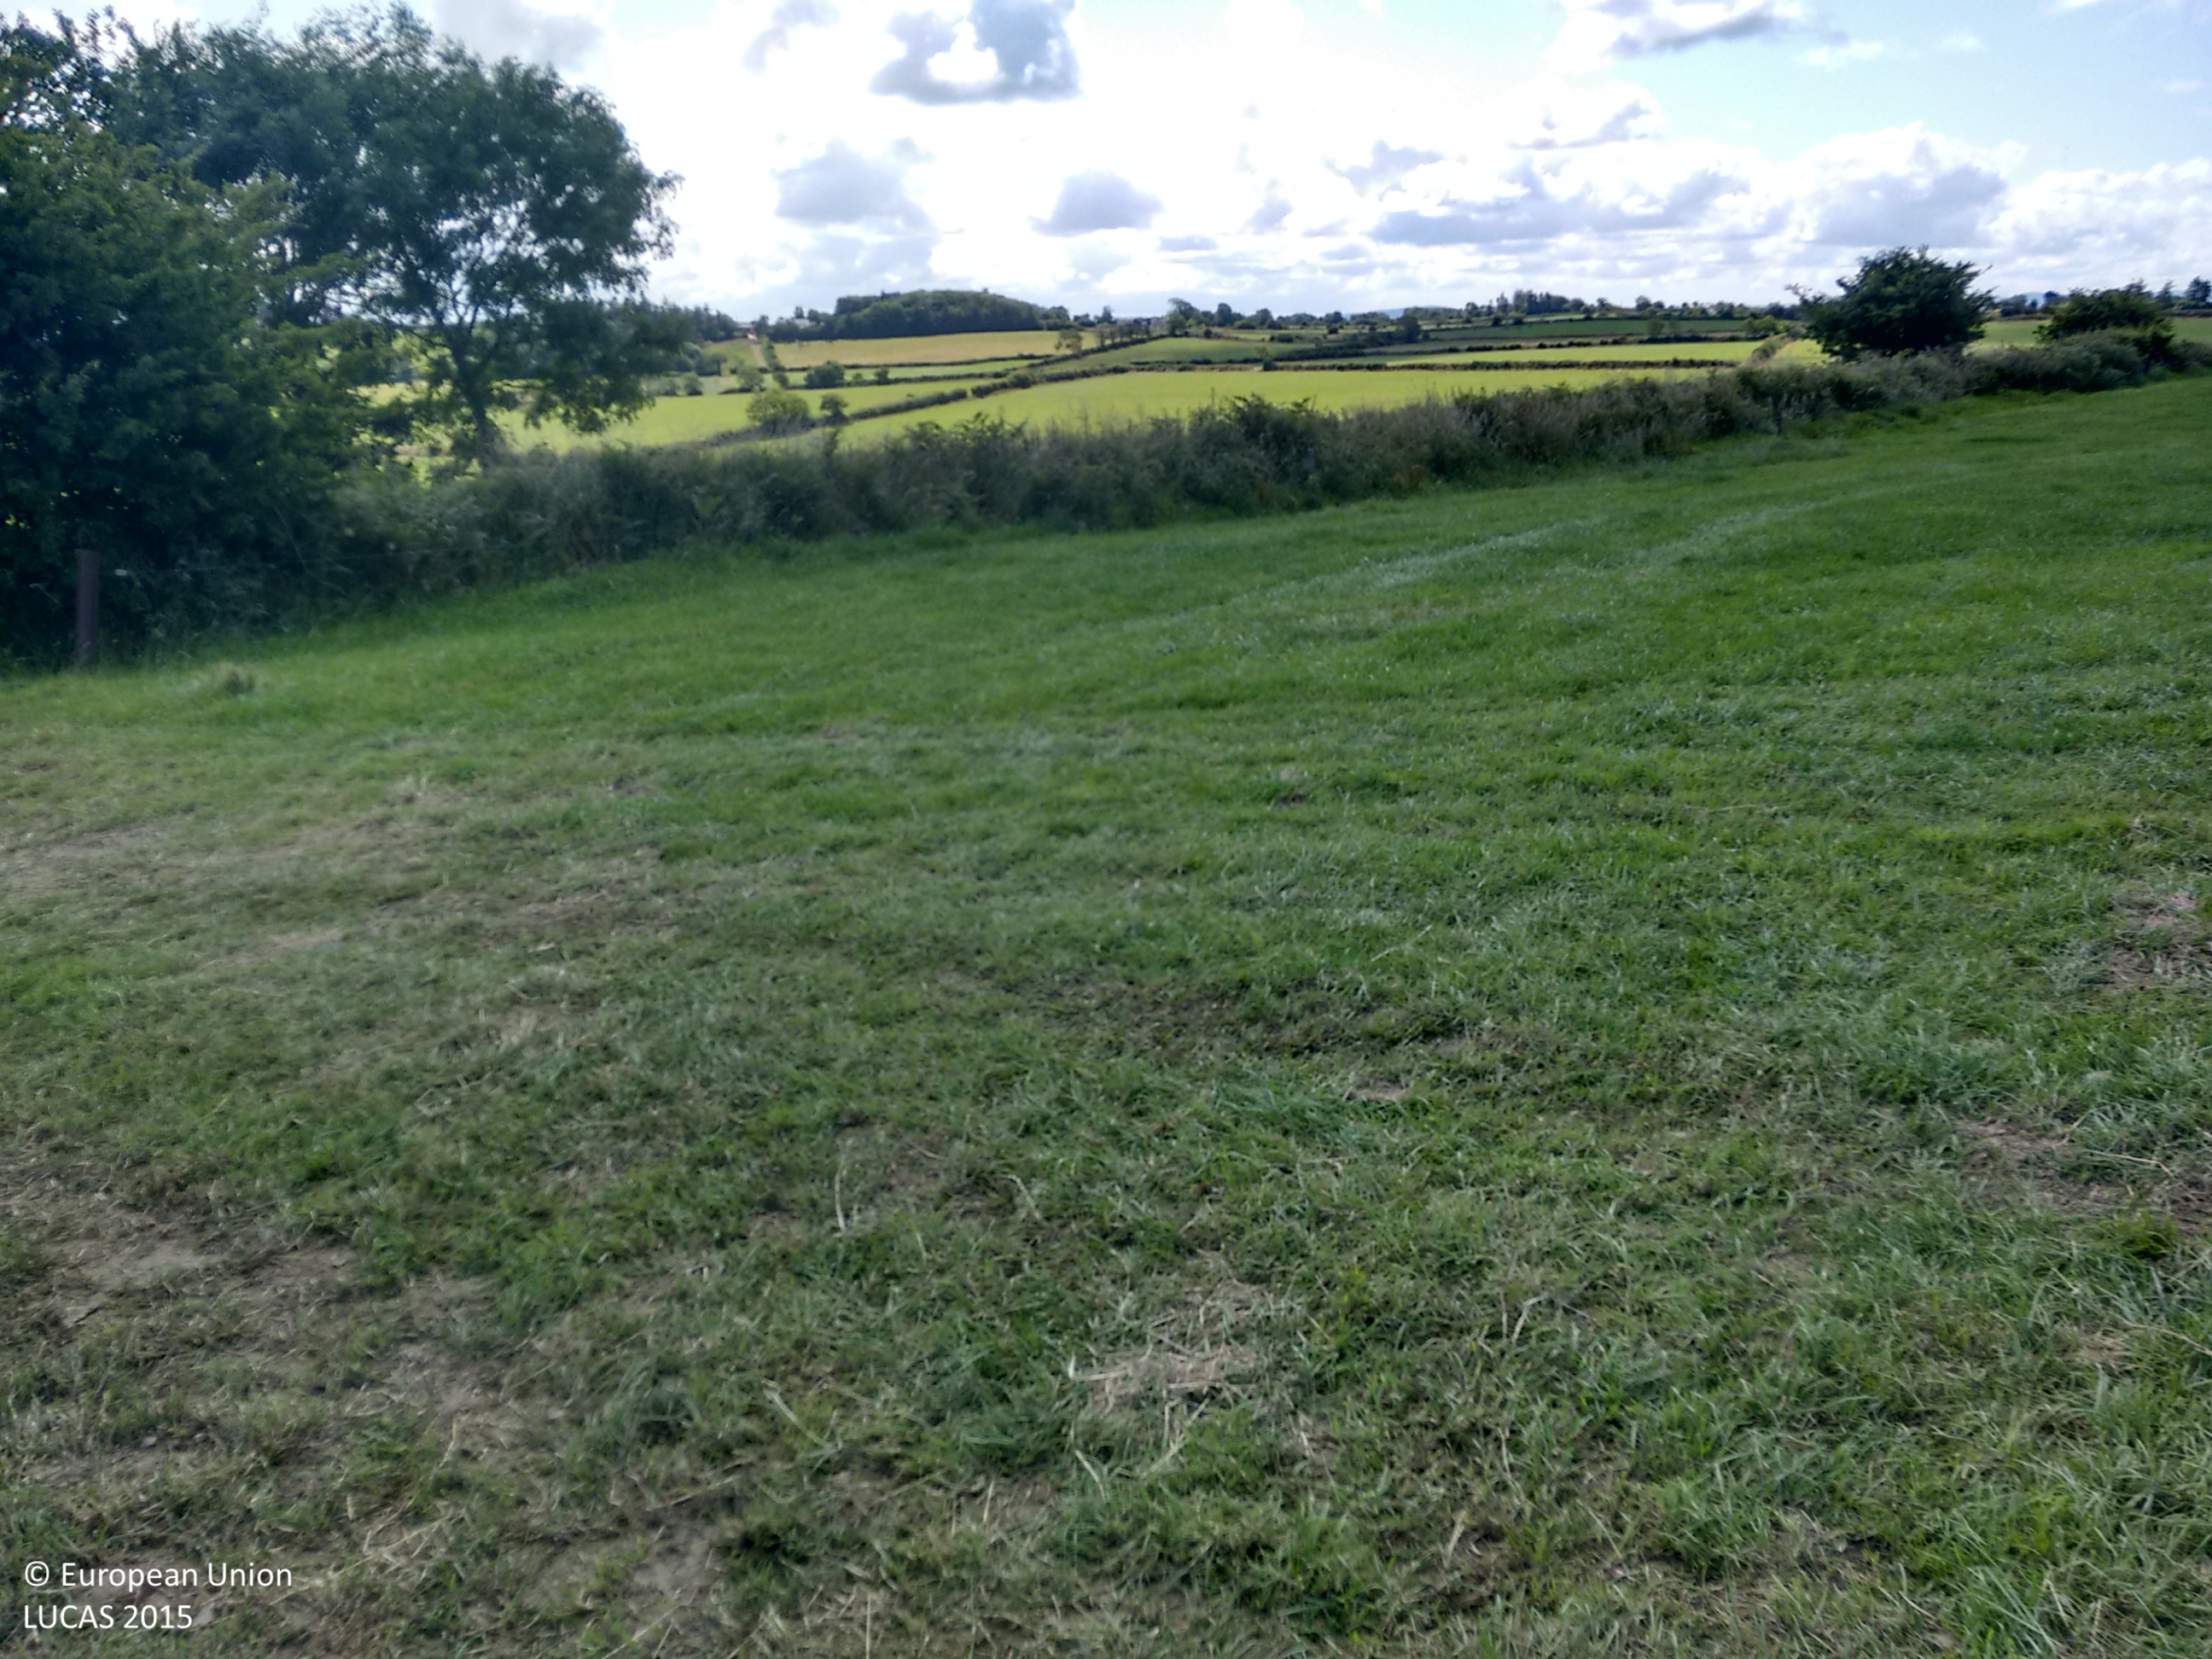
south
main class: Grassland
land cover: Grassland without tree/shrub cover
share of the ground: > 75 %
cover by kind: herbaceous plants 95 %, shrubs 5 %
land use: Agriculture (excluding fallow land and kitchen gardens)
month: July
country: IE
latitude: 52.2595
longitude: -8.9190
